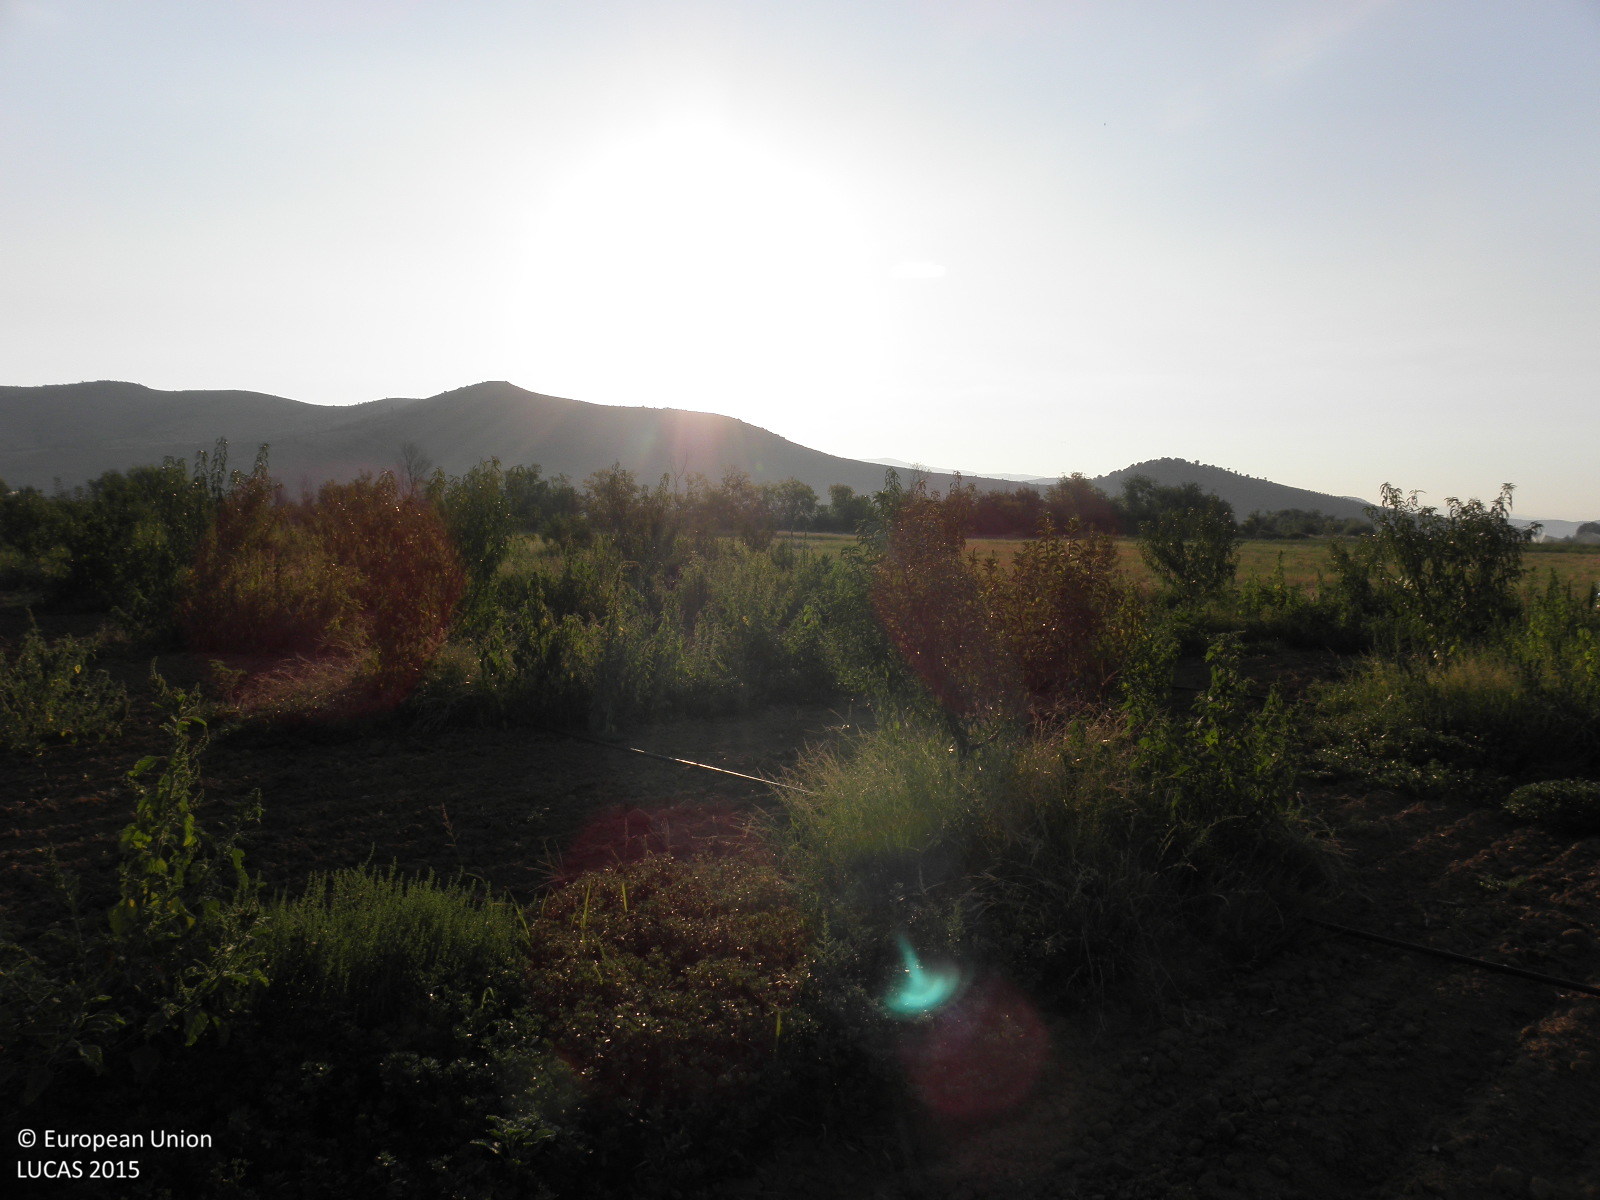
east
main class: Cropland
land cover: Nuts trees
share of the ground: 10 - 25 %
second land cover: Spontaneously vegetated surfaces
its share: 50 - 75 %
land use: Agriculture (excluding fallow land and kitchen gardens)
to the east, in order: Nuts trees; Spontaneously vegetated surfaces; Durum wheat; Abandoned hedges; Tracks; Grass margins; Broadleaved woodland; Ditches and canals; Broadleaved woodland; Nuts trees; Durum wheat
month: August
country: GR
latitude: 39.7669
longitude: 22.4239
